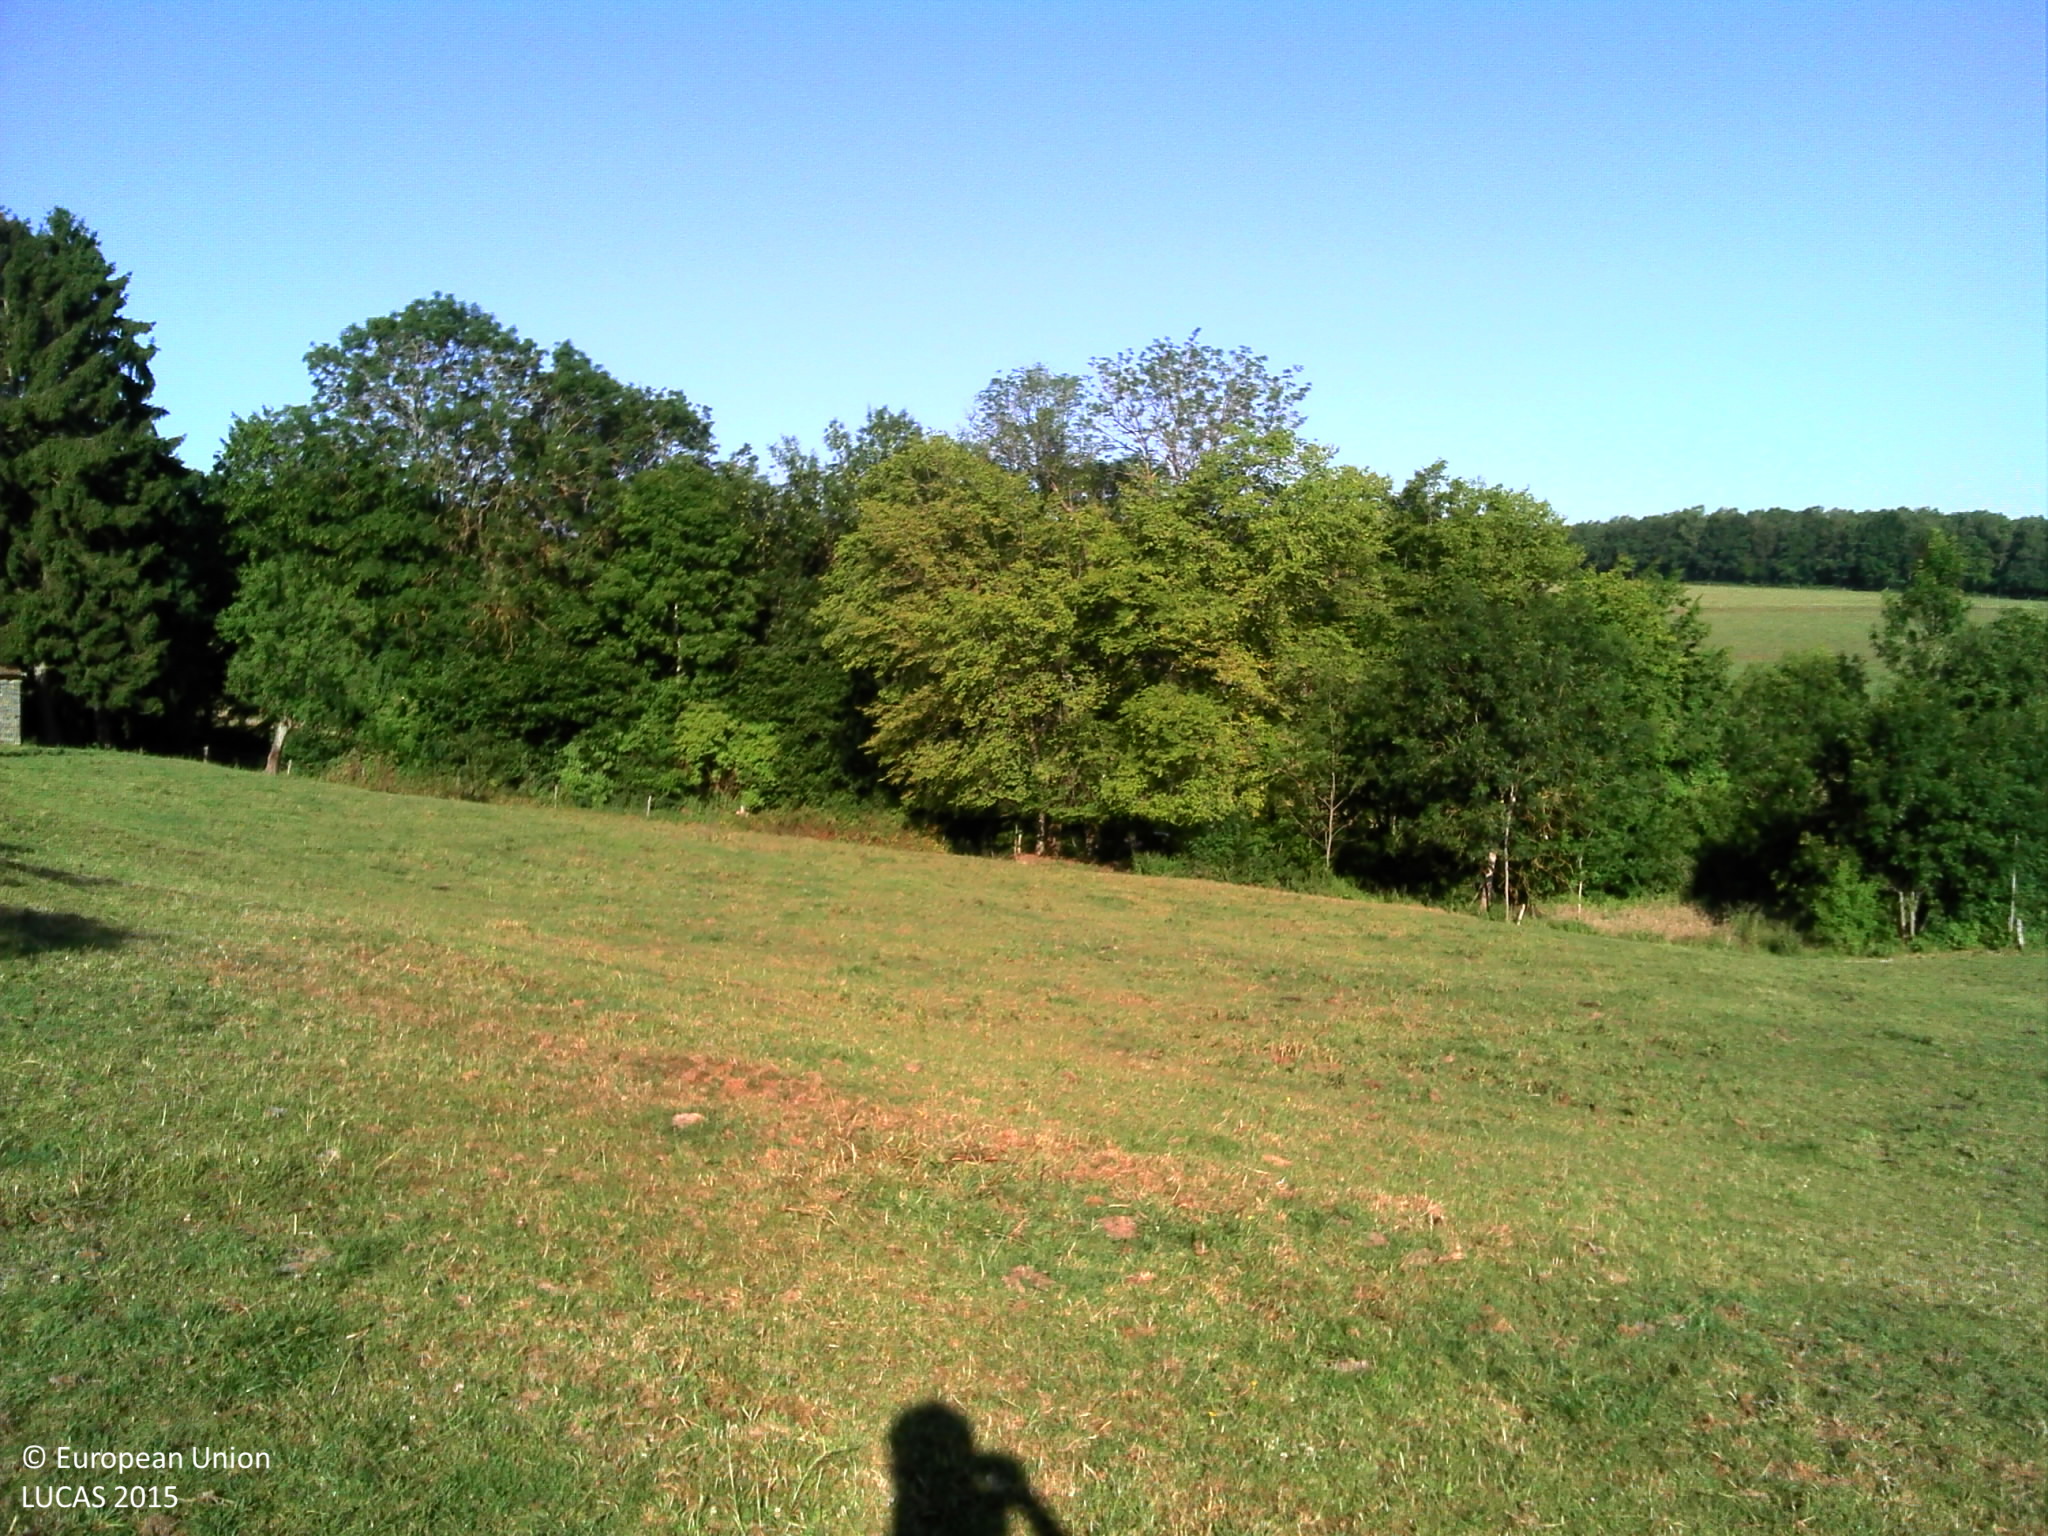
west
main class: Grassland
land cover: Grassland without tree/shrub cover
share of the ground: > 75 %
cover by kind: herbaceous plants 100 %
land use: Agriculture (excluding fallow land and kitchen gardens)
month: July
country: BE
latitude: 50.1372
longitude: 5.6473
